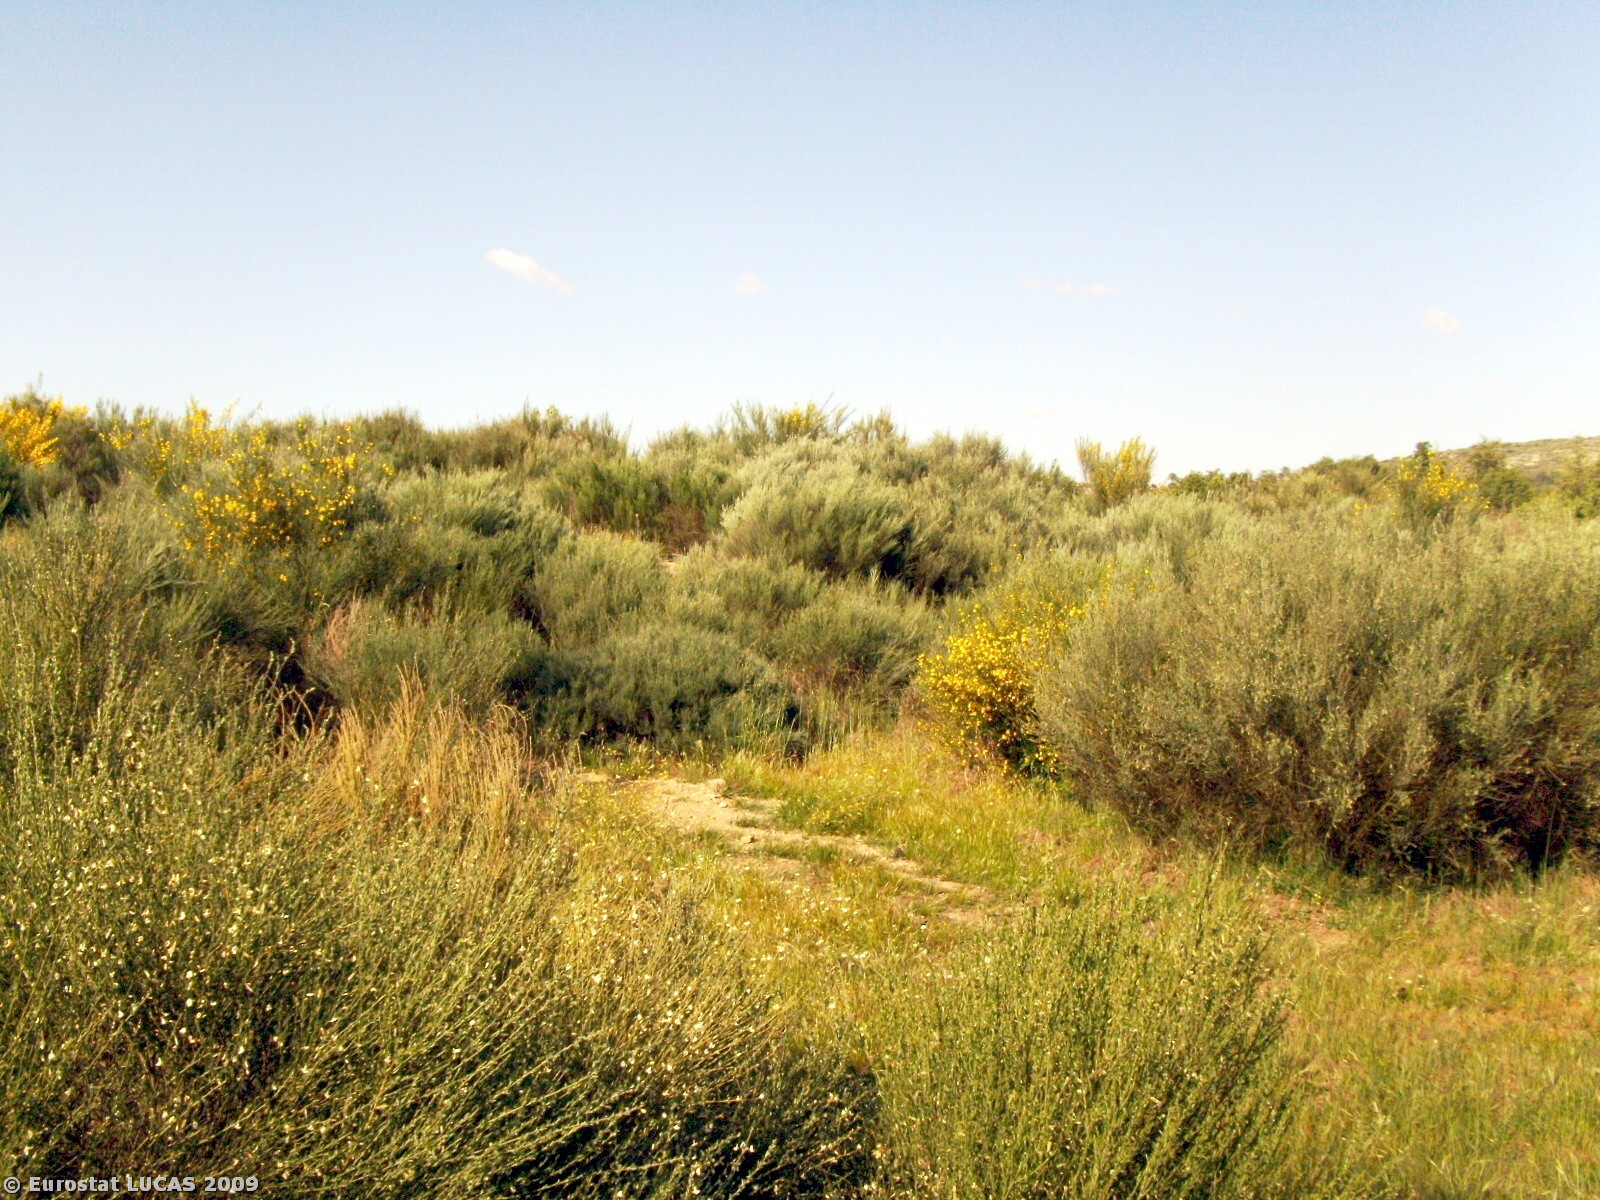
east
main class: Shrubland
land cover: Shrubland with sparse tree cover
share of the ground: > 75 %
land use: Nature reserves
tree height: > 5 m
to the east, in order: Shrubland with sparse tree cover; Broadleaved woodland; Shrubland with sparse tree cover; Tracks; Broadleaved woodland; Rye; Broadleaved woodland; Tracks; Broadleaved woodland; Spontaneously vegetated surfaces; Broadleaved woodland; Rivers and streams; Spontaneously vegetated surfaces
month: May
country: PT
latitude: 40.6080
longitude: -7.3527
